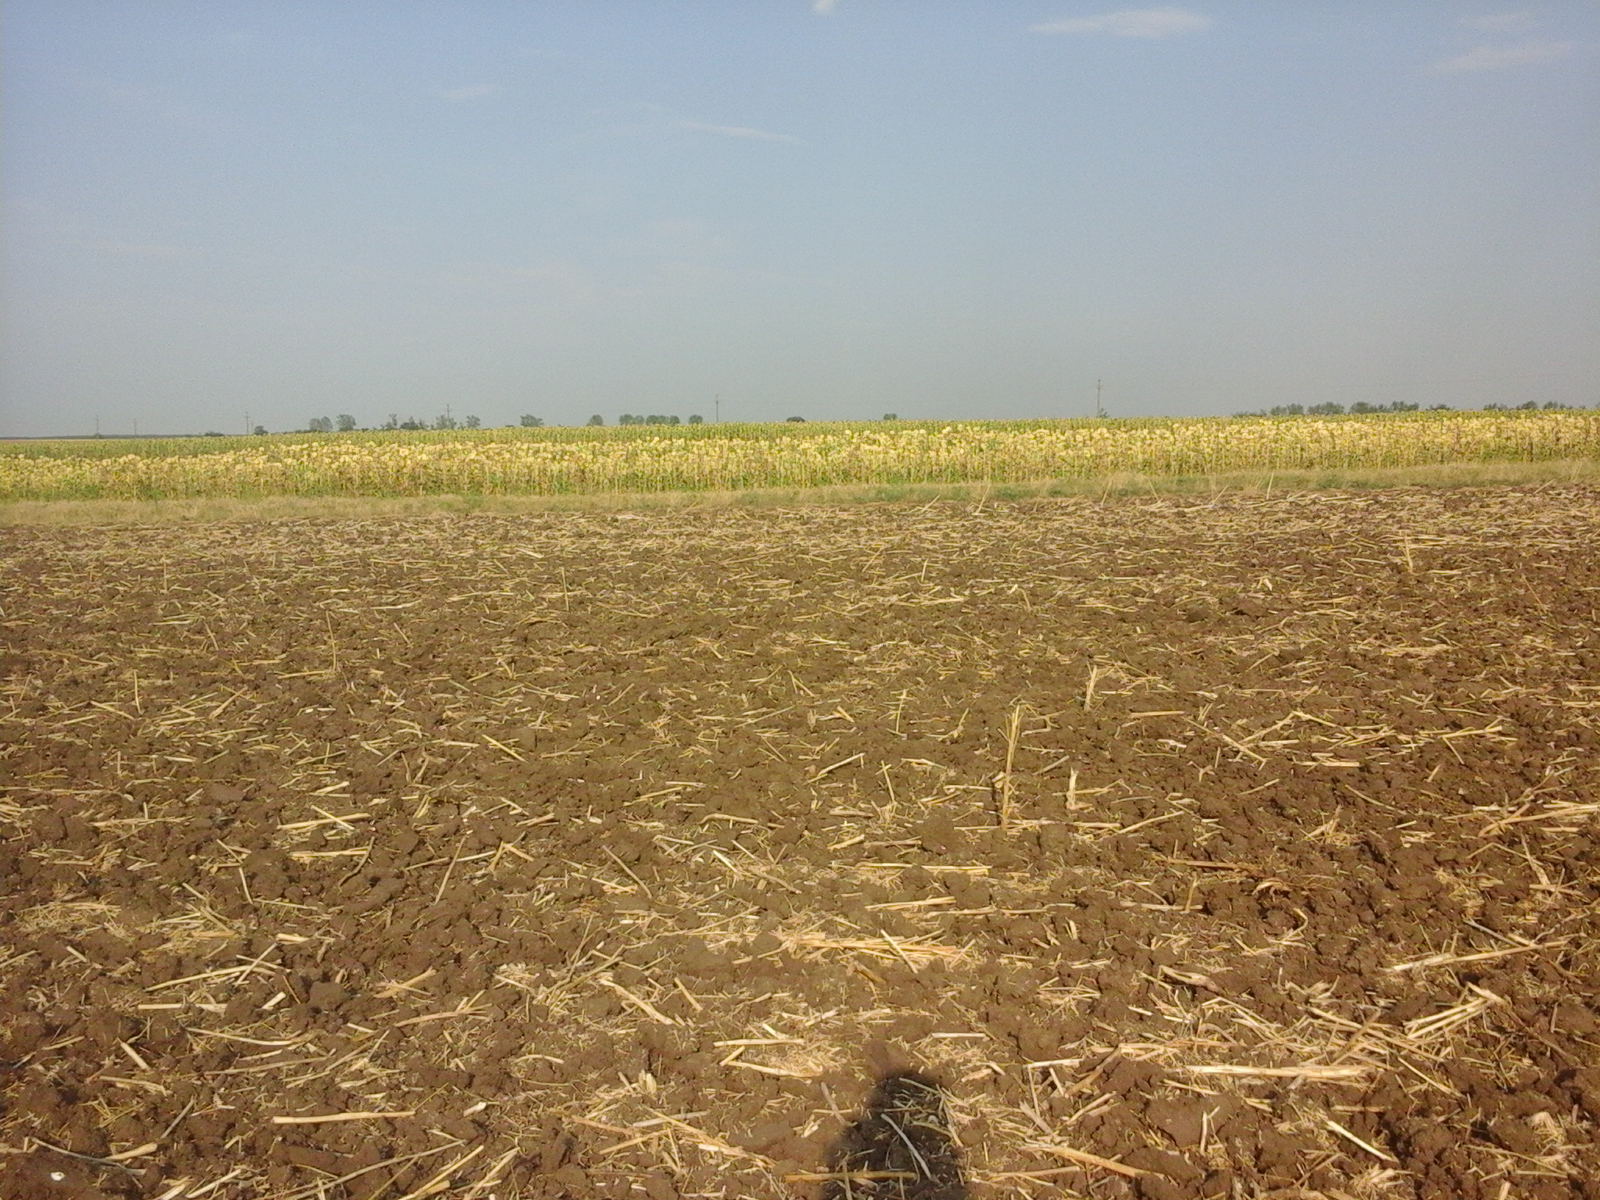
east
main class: Cropland
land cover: Rape and turnip rape
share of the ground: 25 - 50 %
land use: Agriculture (excluding fallow land and kitchen gardens)
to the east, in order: Rape and turnip rape; Grass margins; Tracks; Grass margins; Sunflower; Common wheat; Sunflower; Common wheat
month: August
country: RO
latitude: 44.1090
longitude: 23.4551
